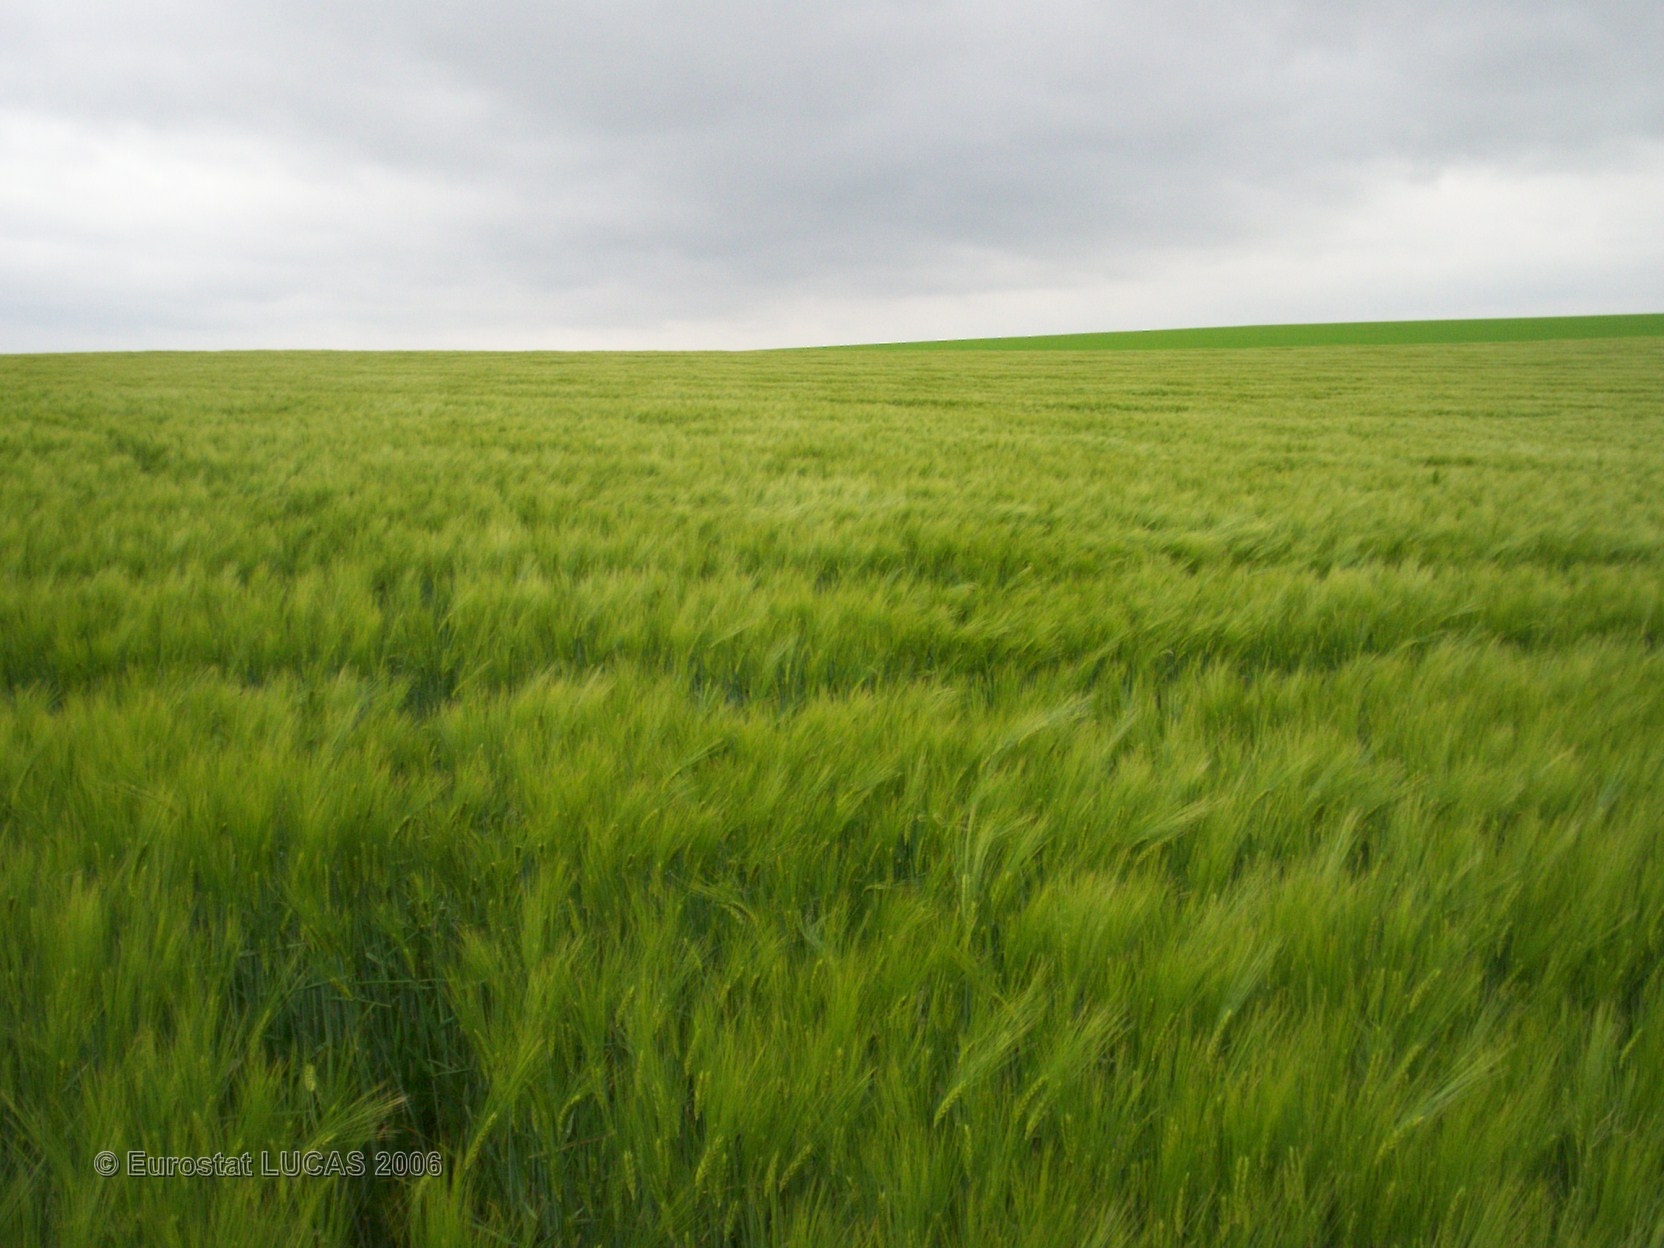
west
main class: Cropland
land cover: Barley
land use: Agriculture (excluding fallow land and kitchen gardens)
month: May
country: FR
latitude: 49.3447
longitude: 4.4216
